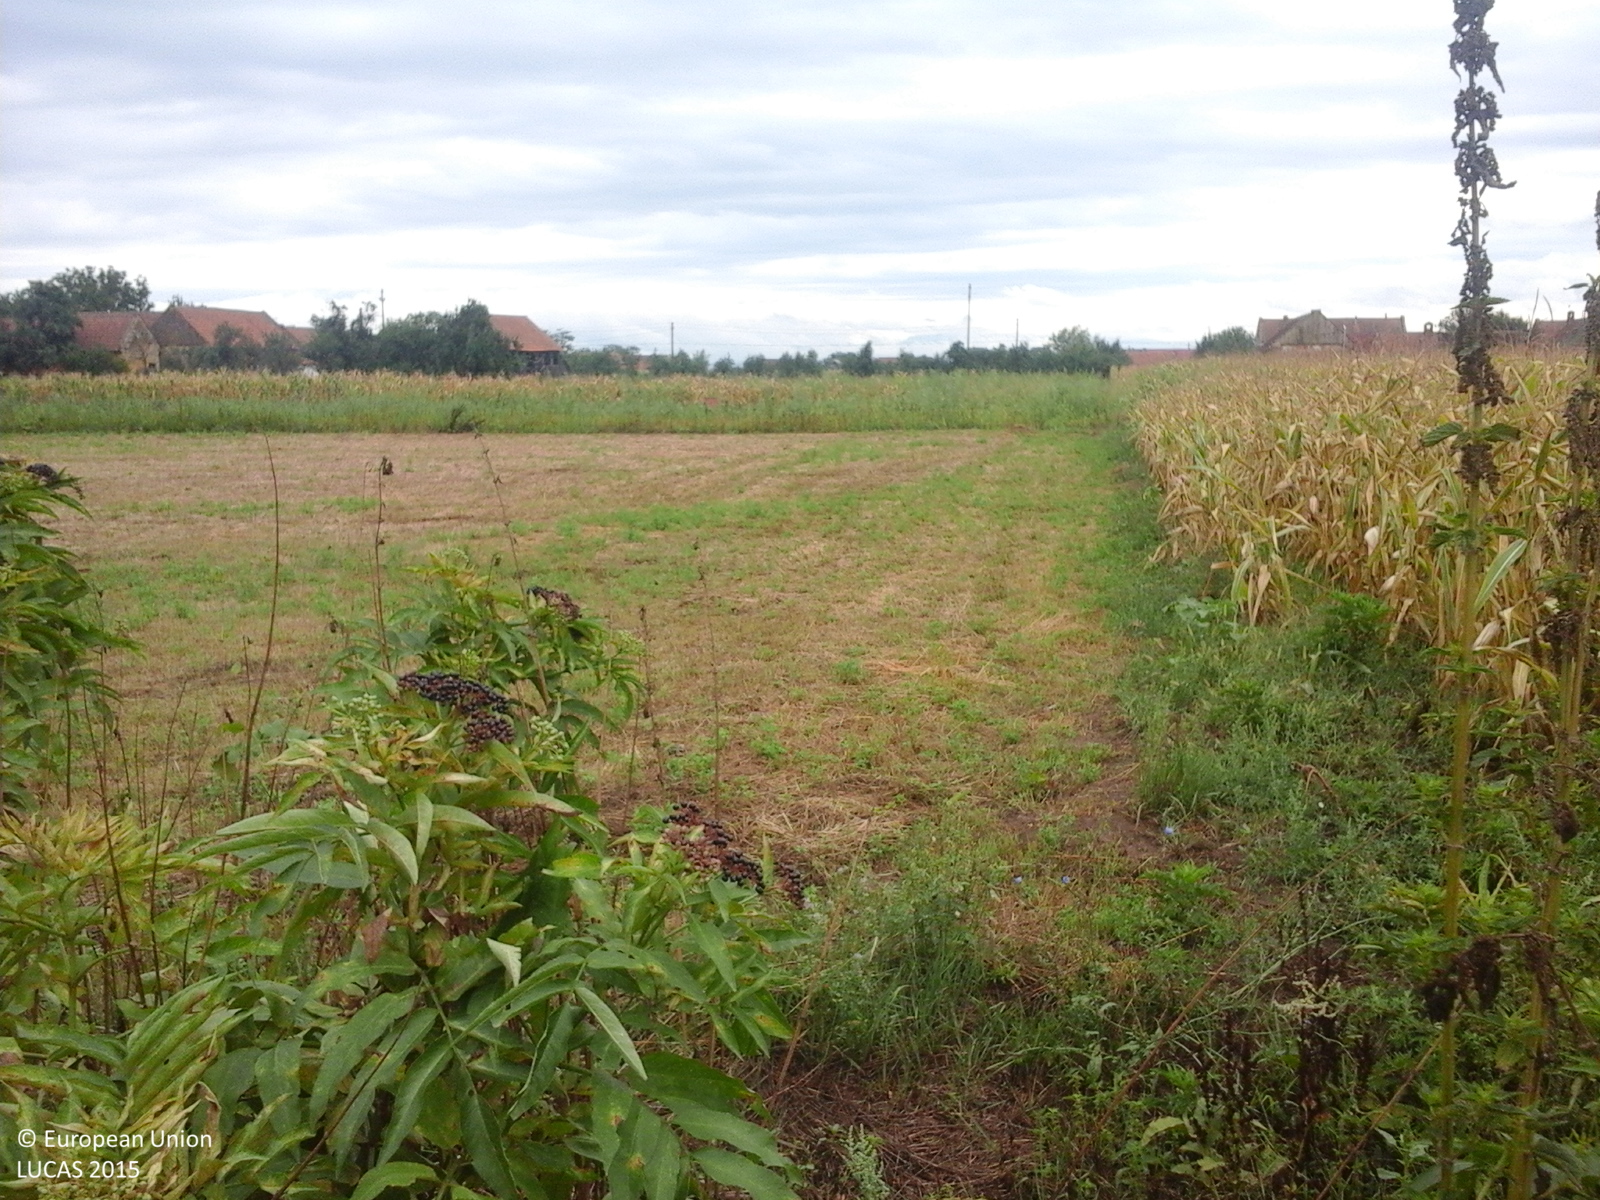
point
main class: Cropland
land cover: Lucerne
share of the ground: > 75 %
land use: Agriculture (excluding fallow land and kitchen gardens)
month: August
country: RO
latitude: 45.7203
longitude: 21.7409
